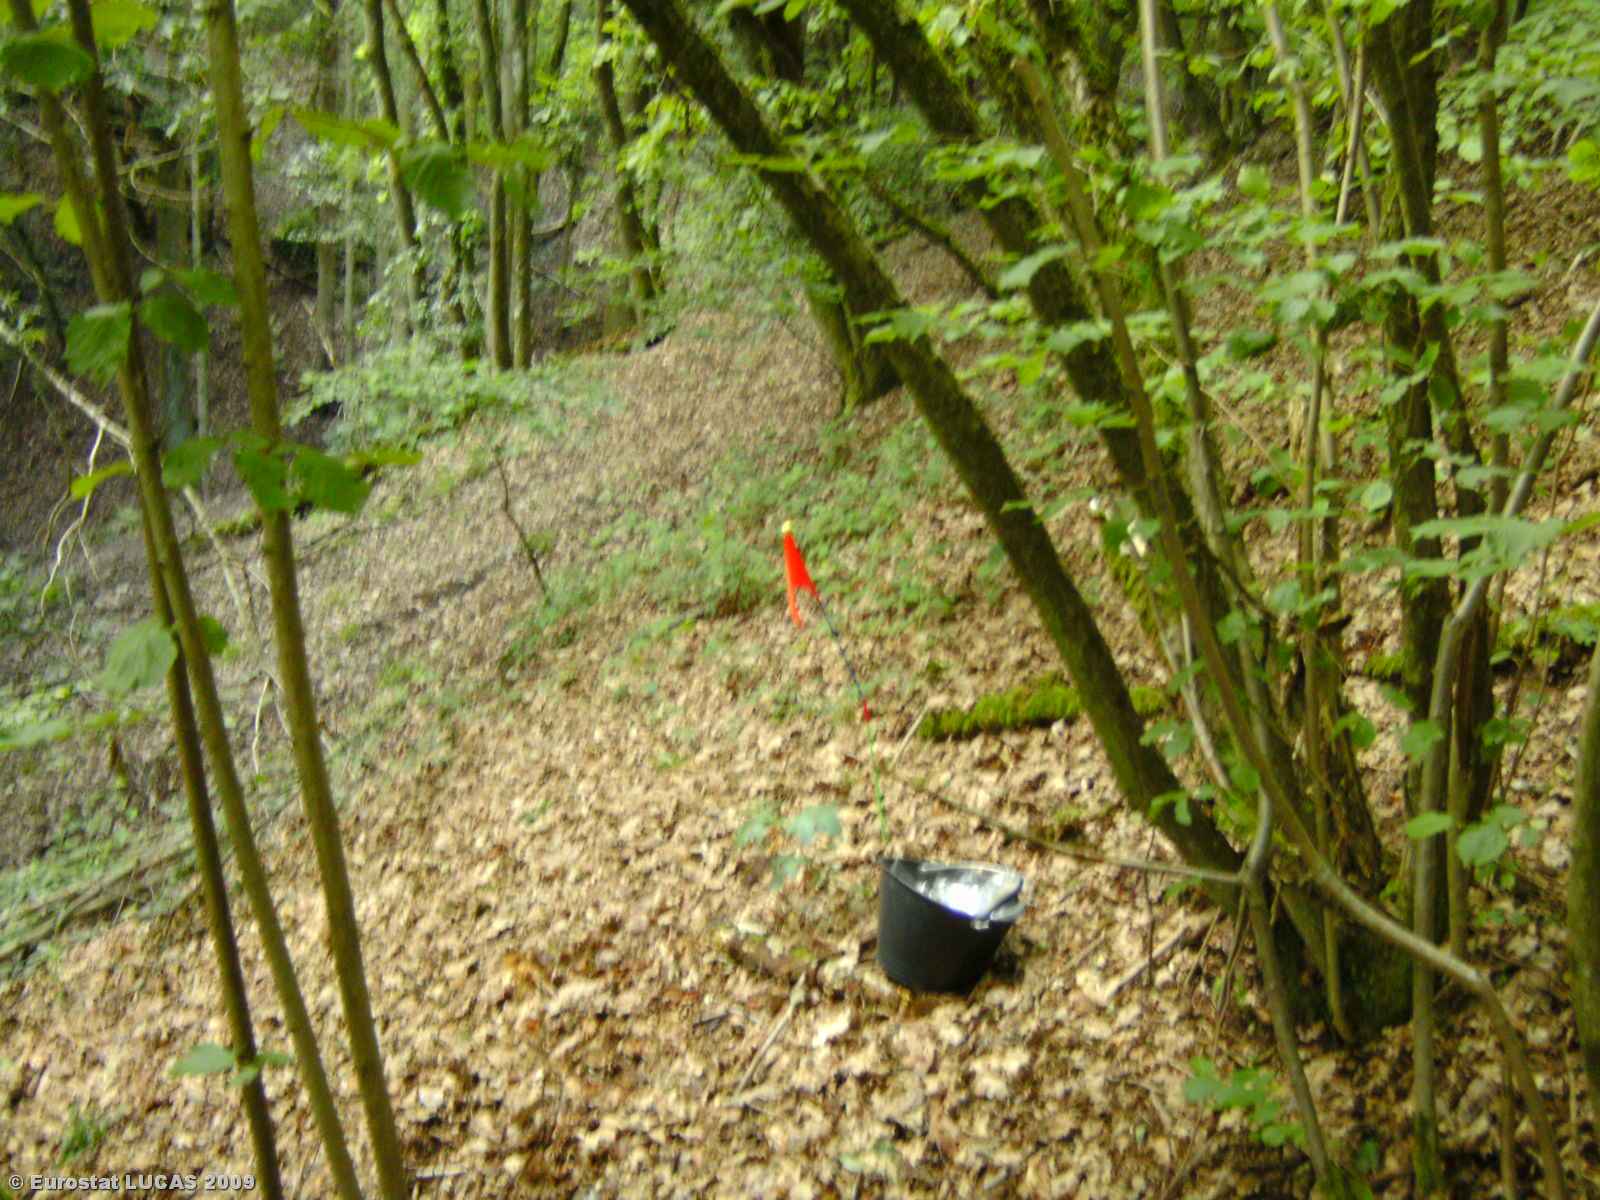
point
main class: Woodland
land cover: Broadleaved woodland
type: mesophytic deciduous forest
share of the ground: > 75 %
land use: Forestry
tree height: > 5 m
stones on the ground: < 10 %
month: June
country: LU
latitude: 49.9219
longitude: 6.1690
